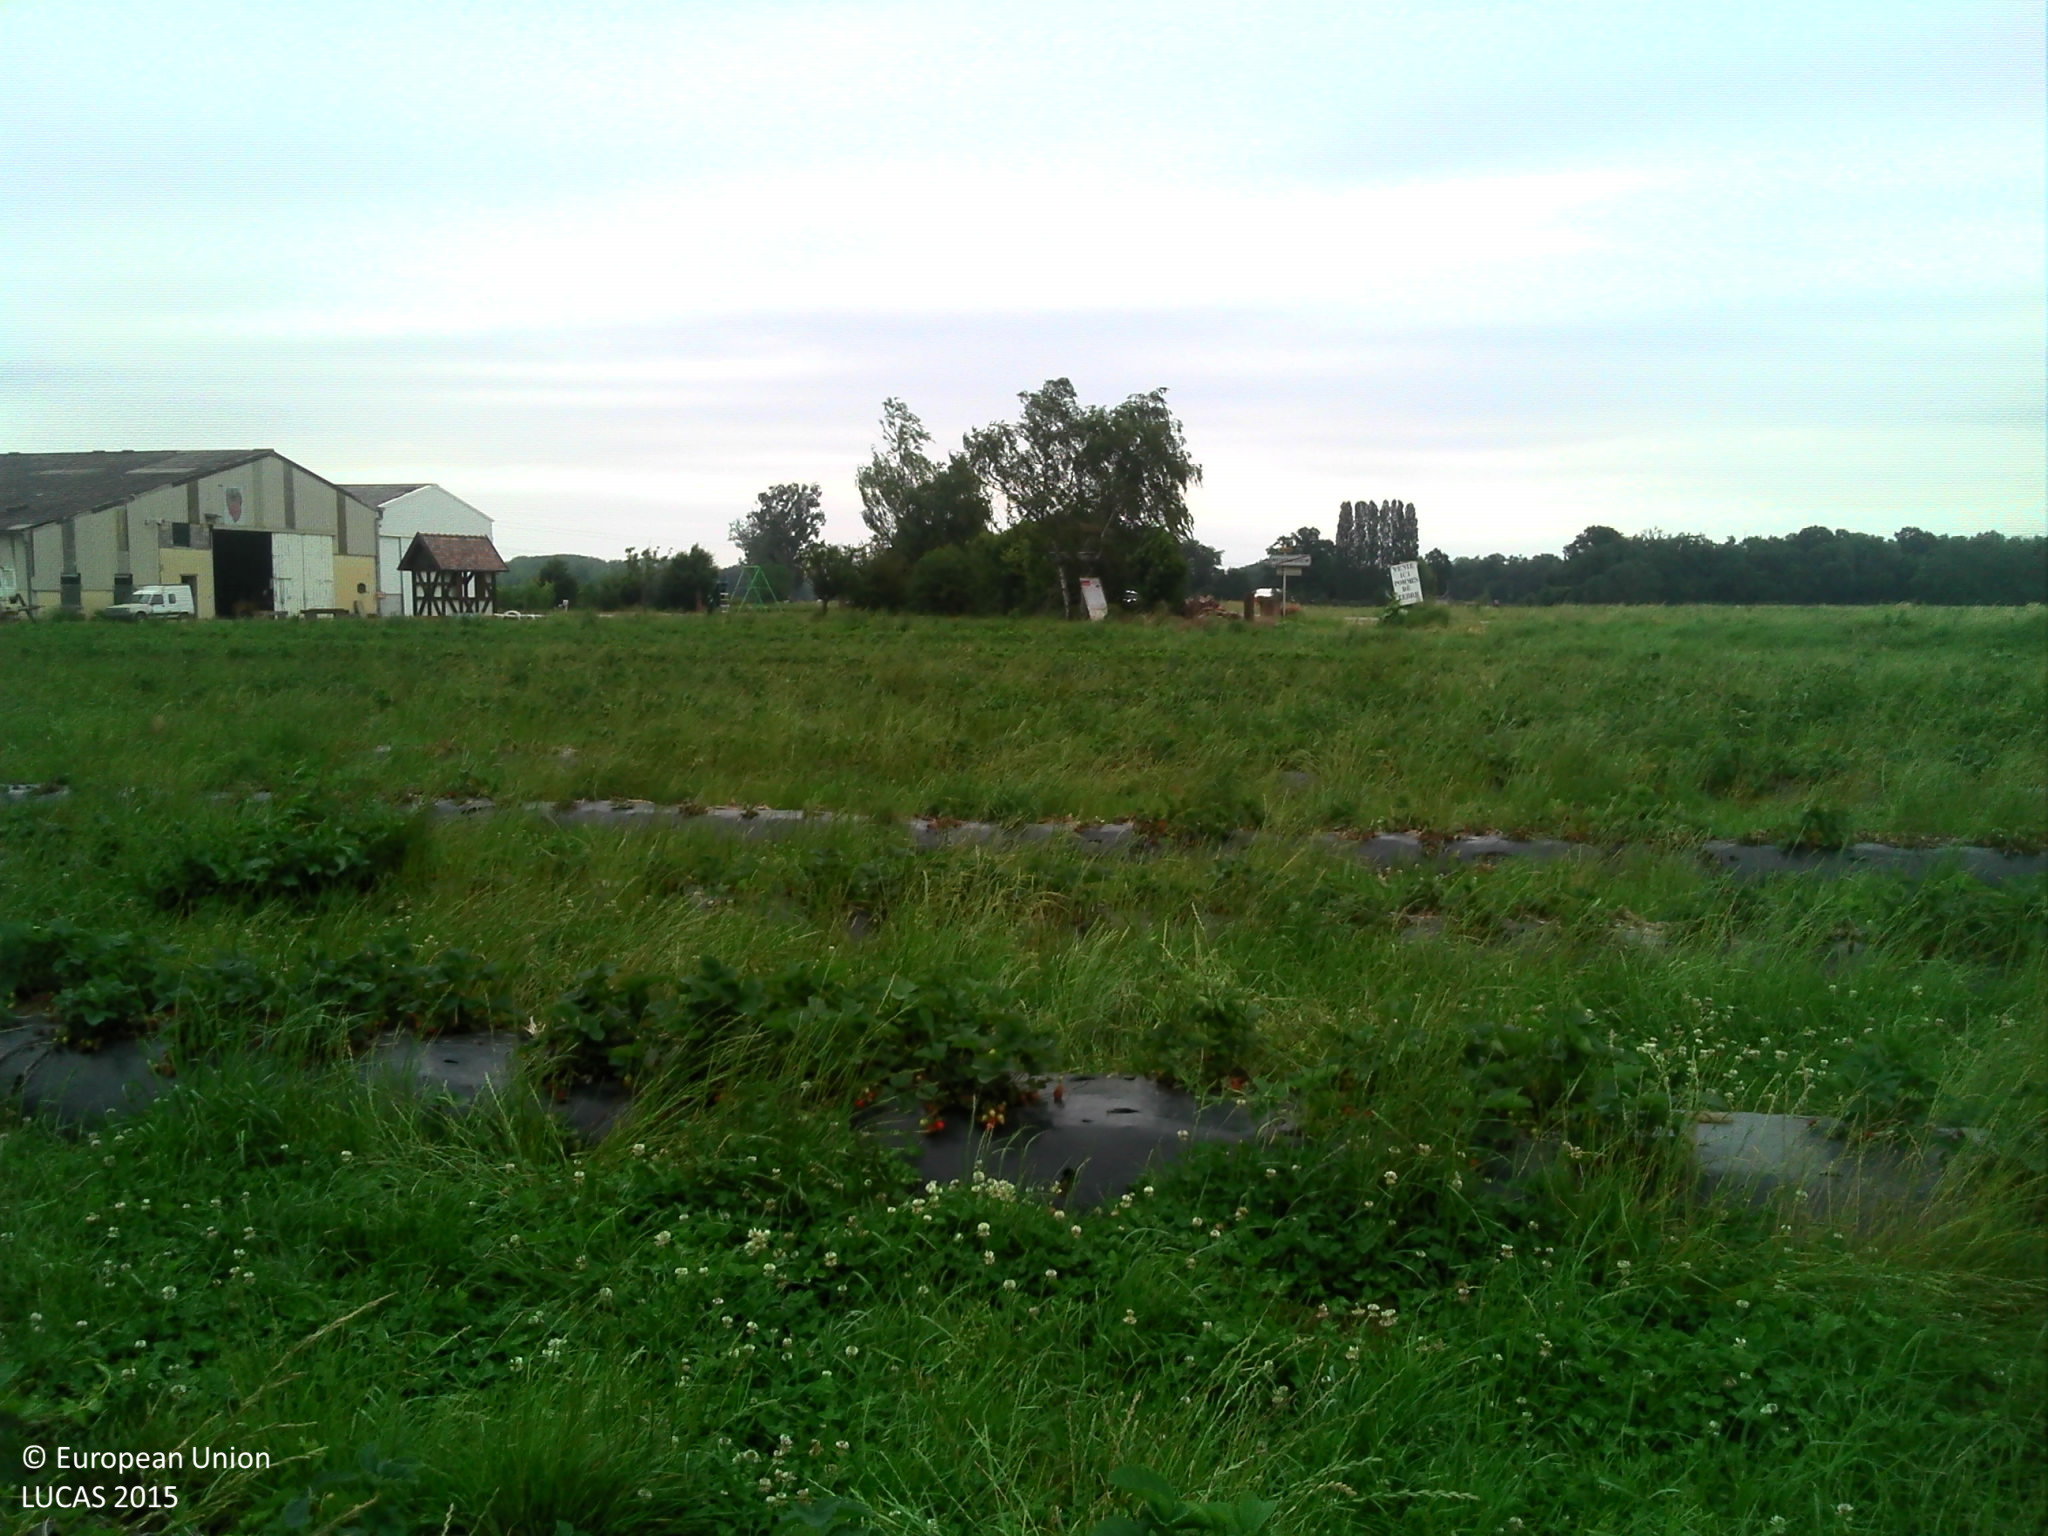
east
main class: Cropland
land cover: Strawberries
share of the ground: 50 - 75 %
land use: Agriculture (excluding fallow land and kitchen gardens)
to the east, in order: Strawberries; Grassland with sparse tree/shrub cover; Managed hedges; Dry stone walls; Tracks; Grassland without tree/shrub cover; Abandoned hedges; Ditches and canals; Grass margins; Paved roads, cycling and walking lanes
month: June
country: FR
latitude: 48.4485
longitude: 7.5538
